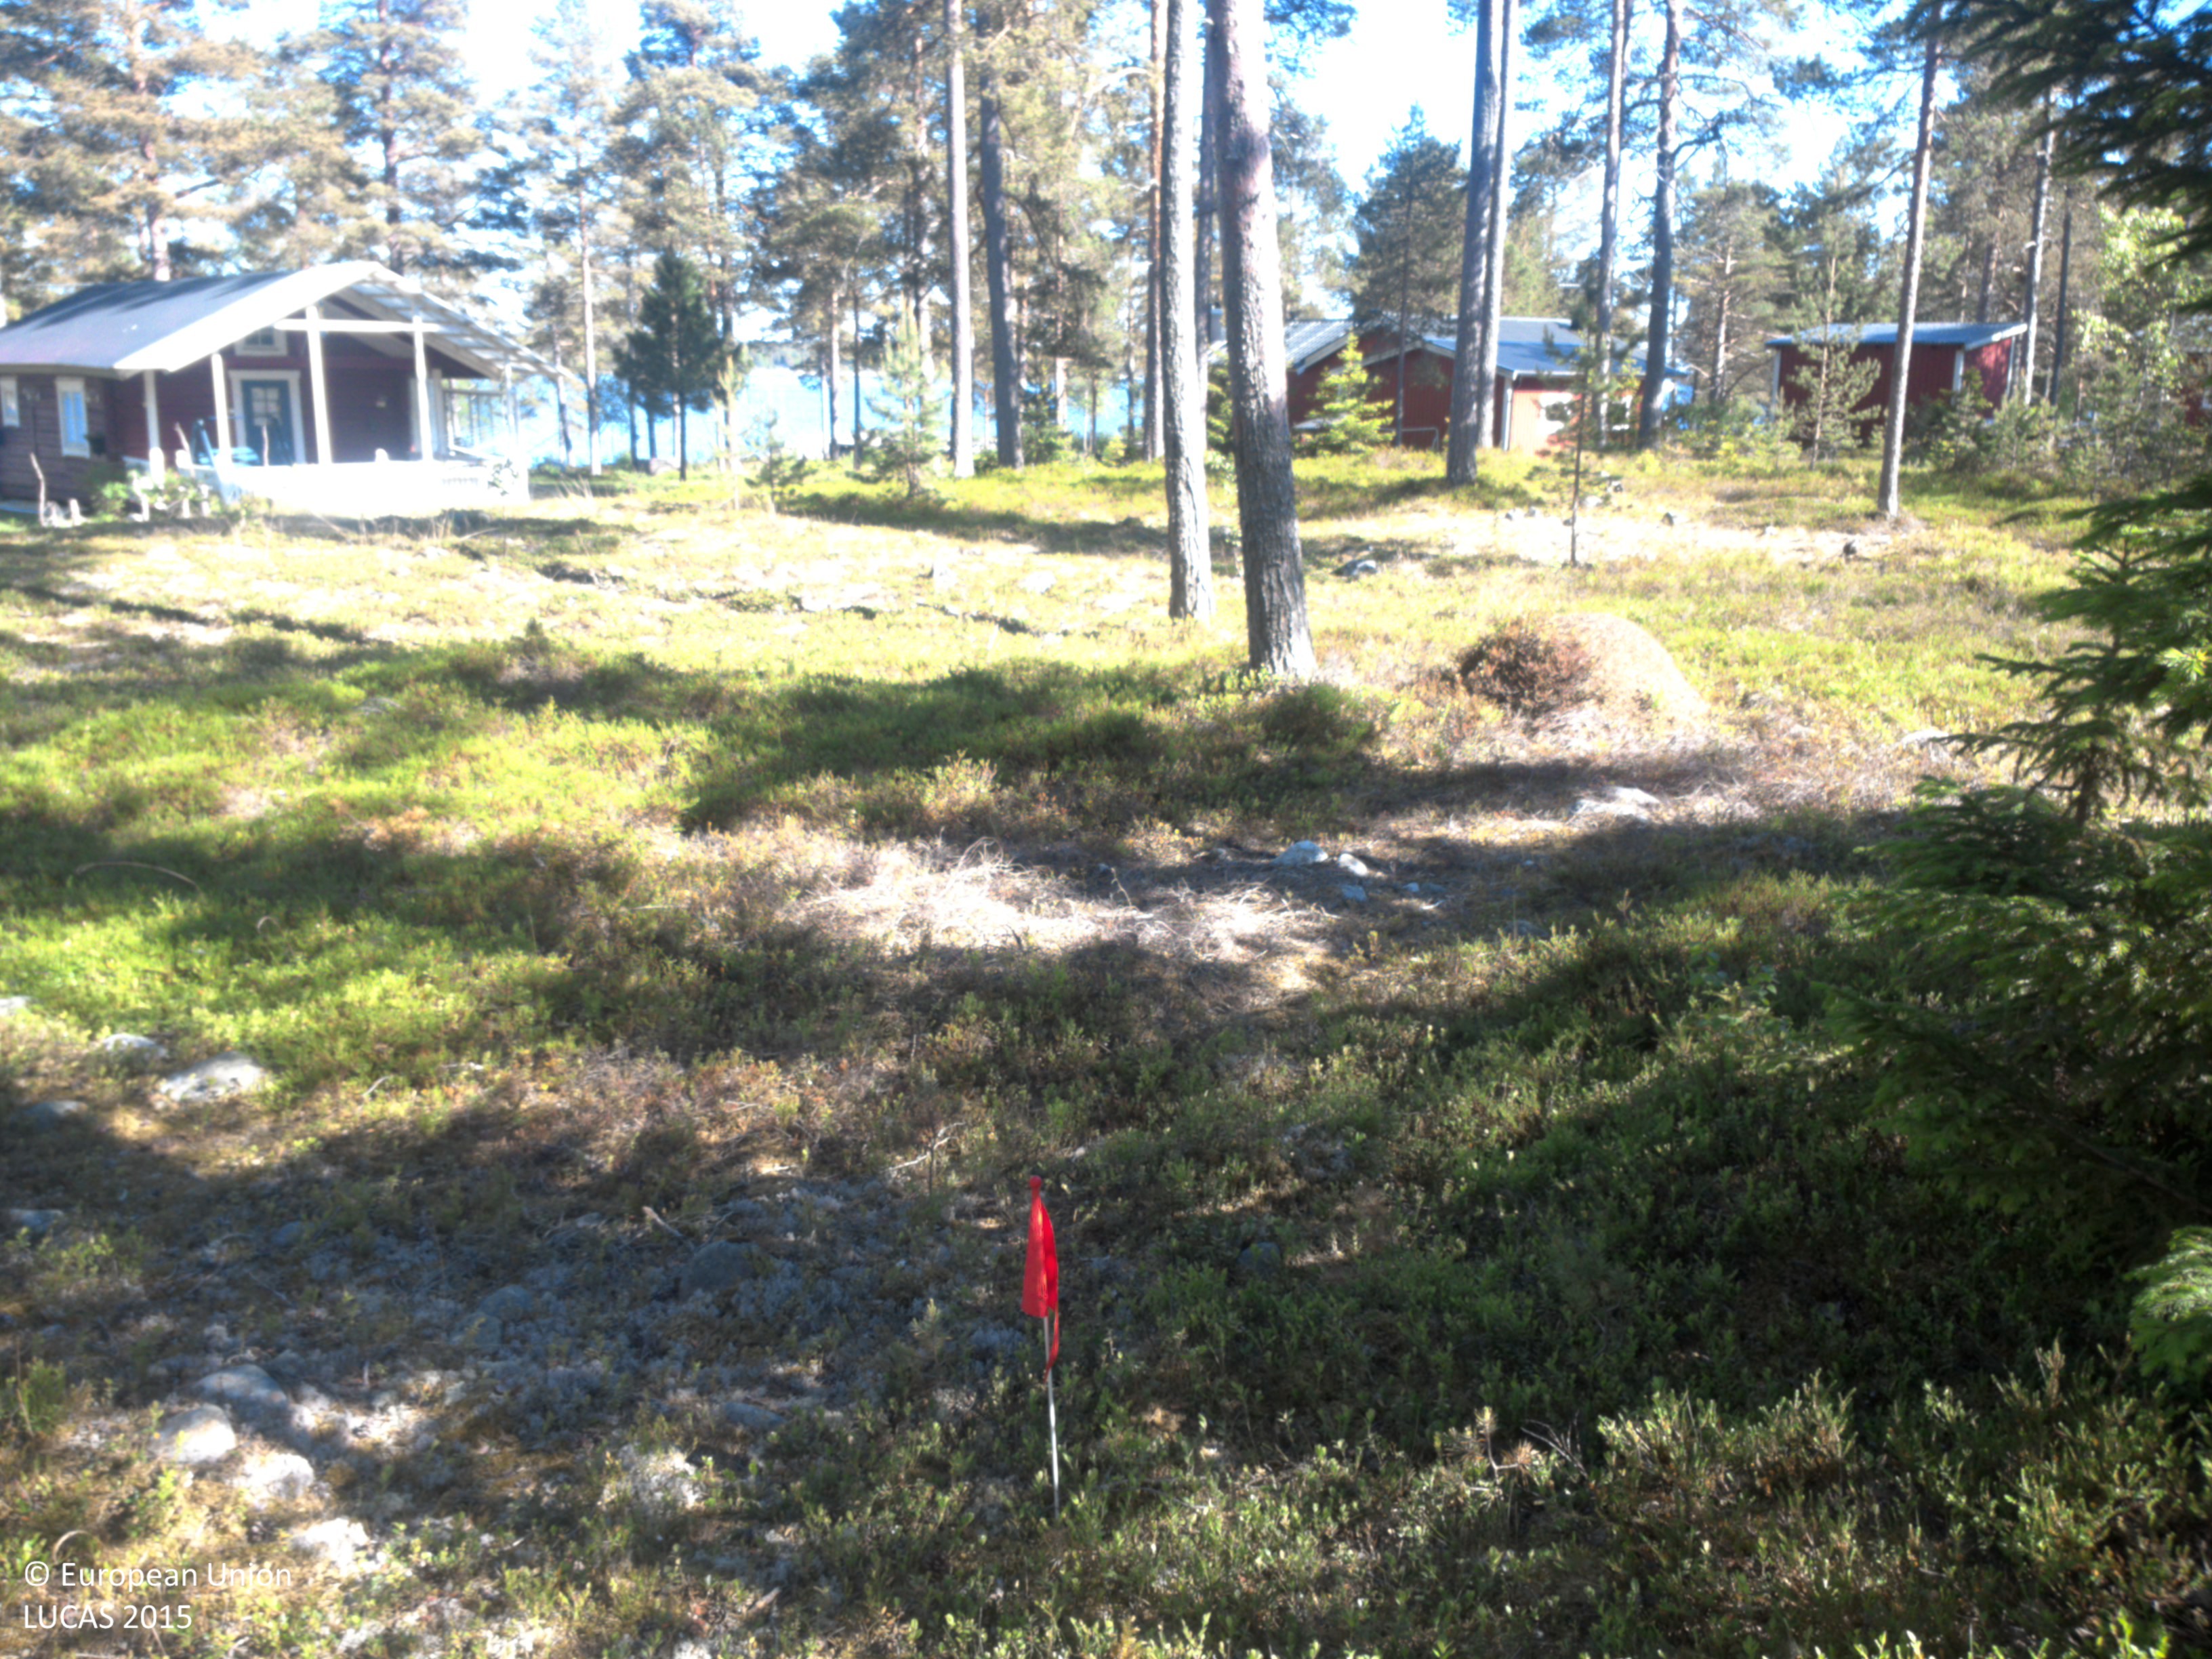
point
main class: Woodland
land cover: Pine dominated coniferous woodland
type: boreal forest
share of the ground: 25 - 50 %
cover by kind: lichens and mosses 65 %, coniferous forest trees 25 %, herbaceous plants 10 %
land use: Residential
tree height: > 5 m
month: June
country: SE
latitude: 63.4497
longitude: 19.6265
